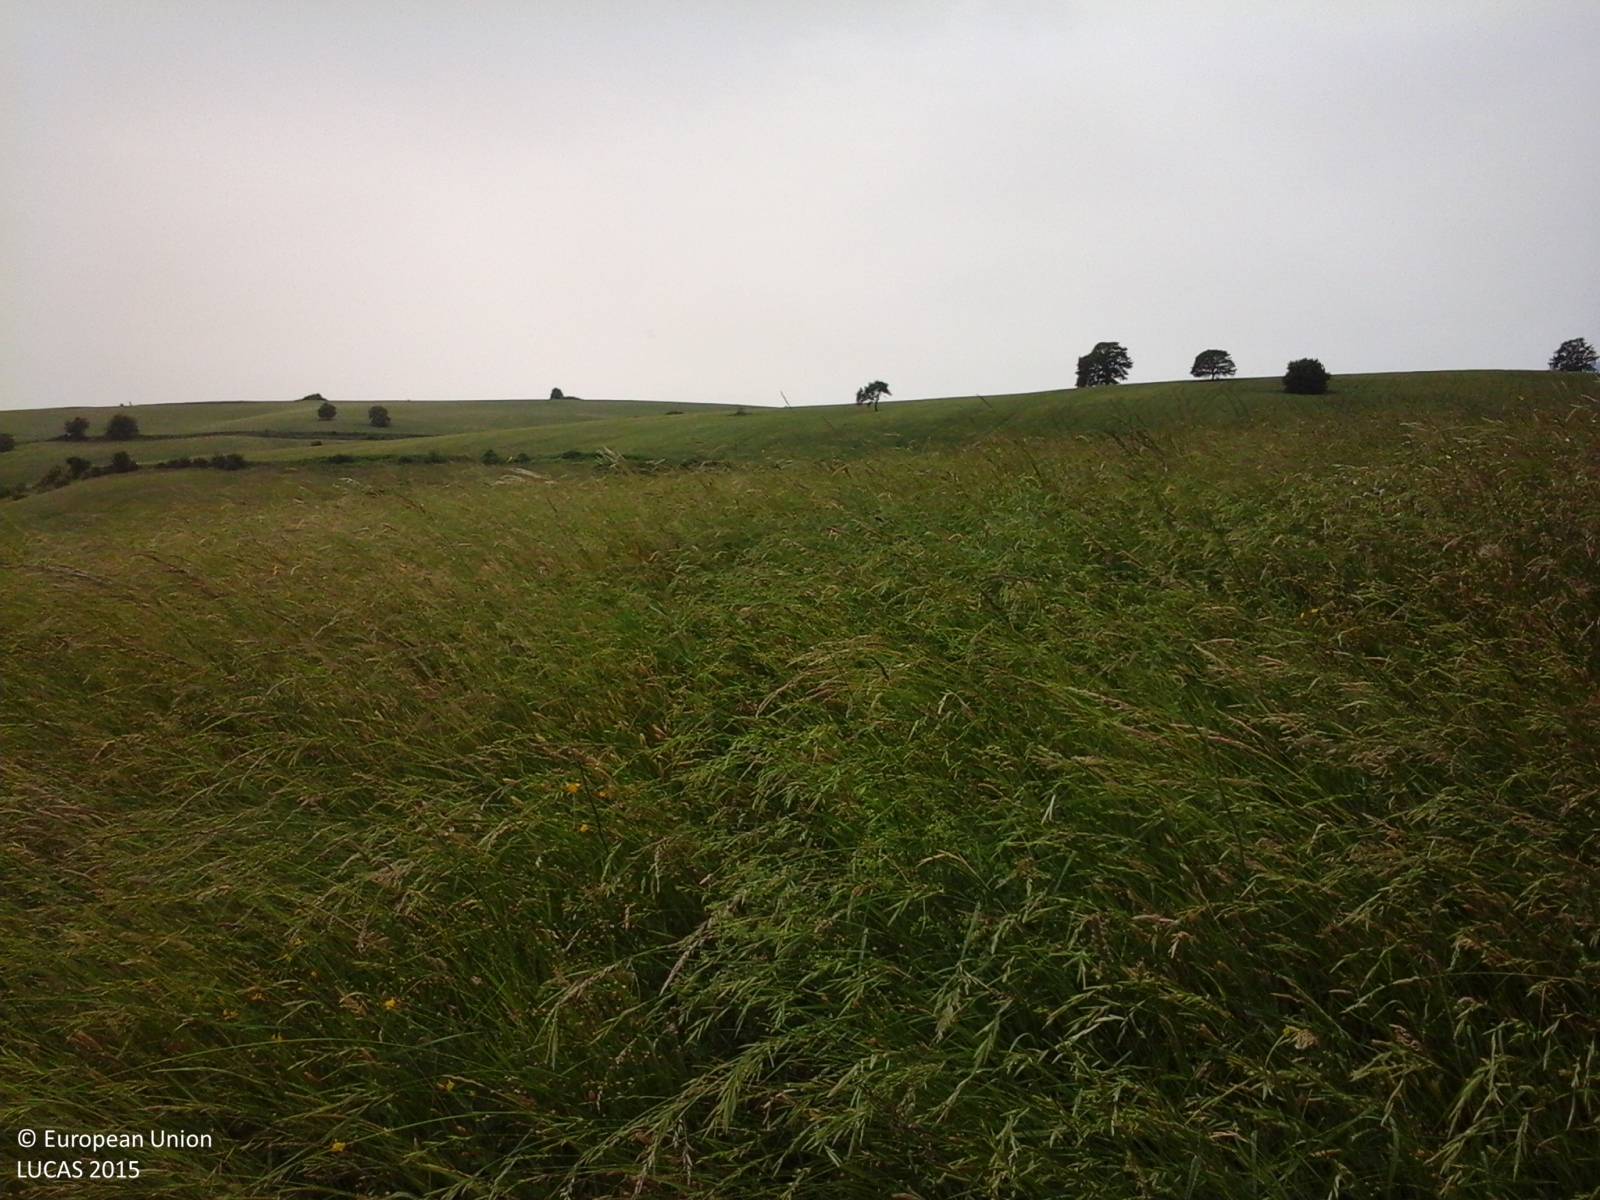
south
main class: Cropland
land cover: Other leguminous and mixtures for fodder
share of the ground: > 75 %
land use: Agriculture (excluding fallow land and kitchen gardens)
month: June
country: IT
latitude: 41.9661
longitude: 14.2936
